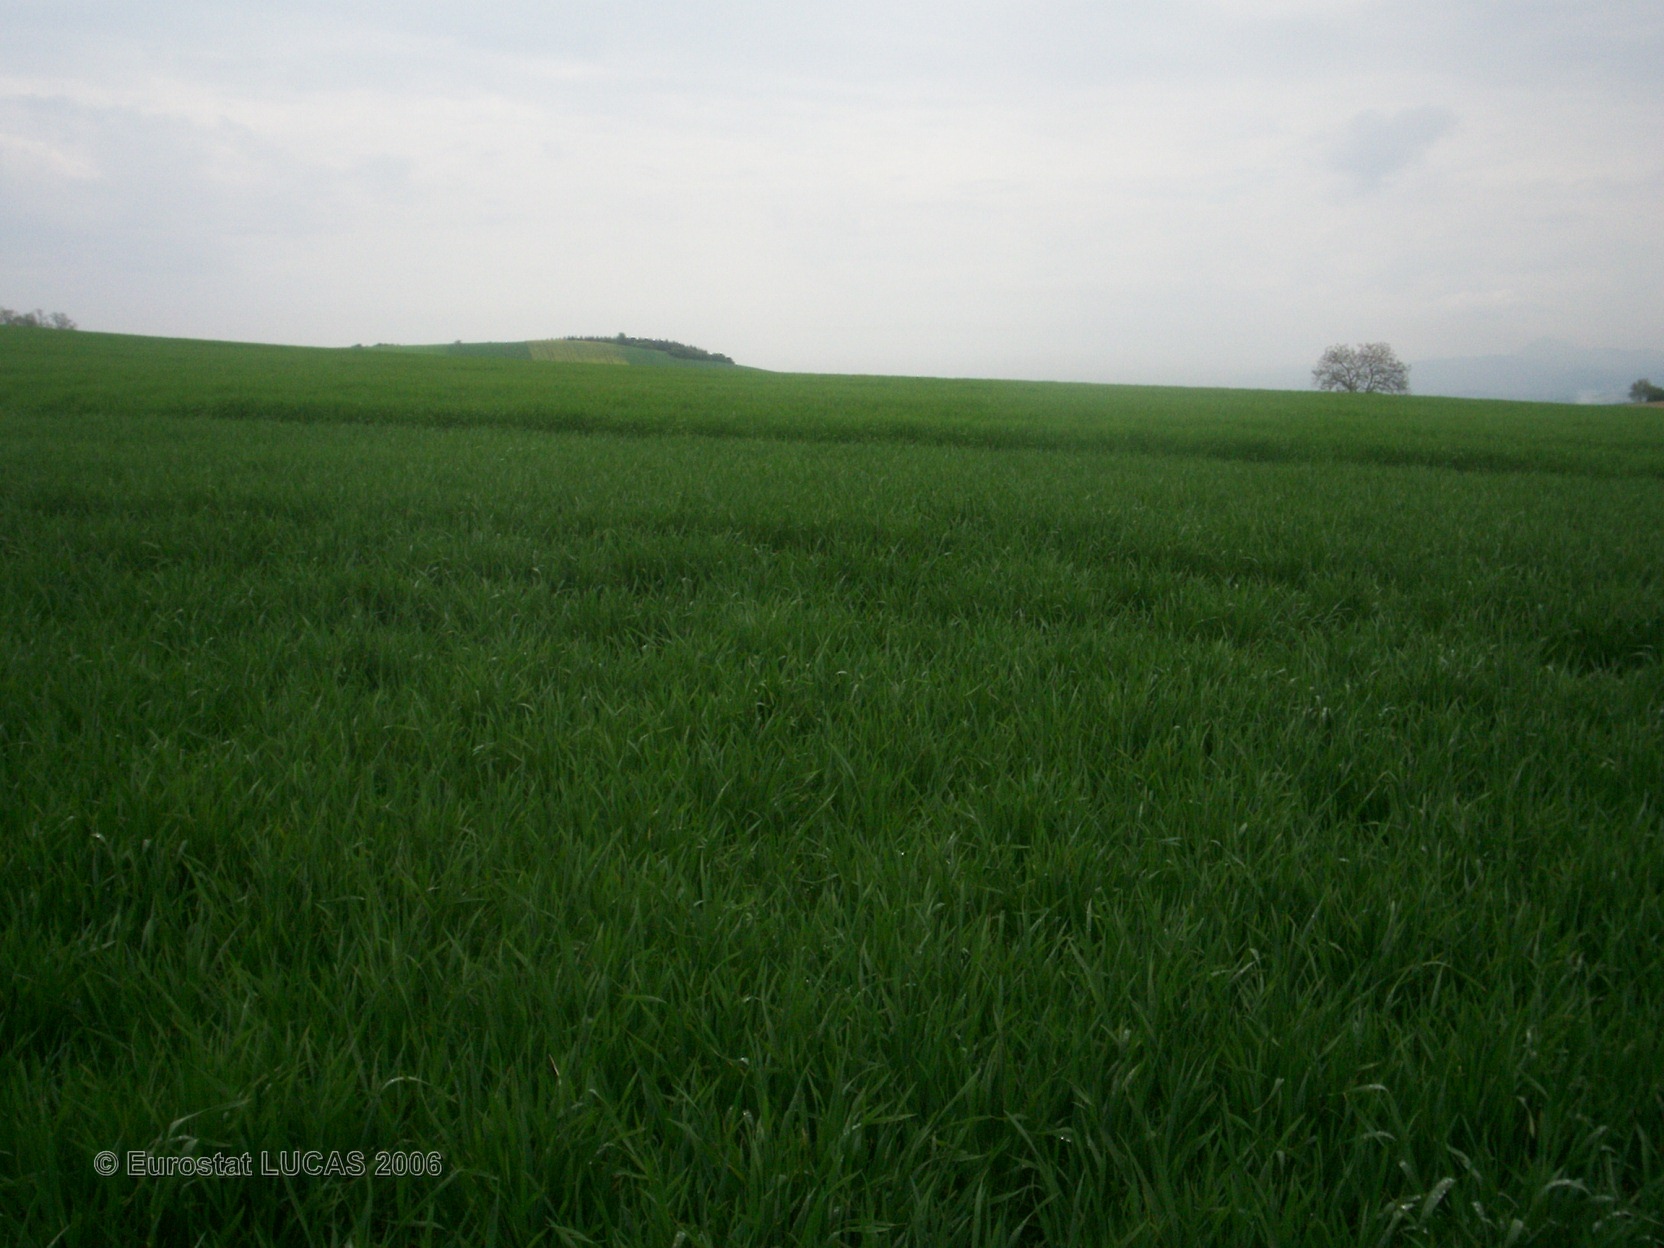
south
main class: Cropland
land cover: Common wheat
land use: Agriculture (excluding fallow land and kitchen gardens)
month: May
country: FR
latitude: 46.0224
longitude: 3.1398
